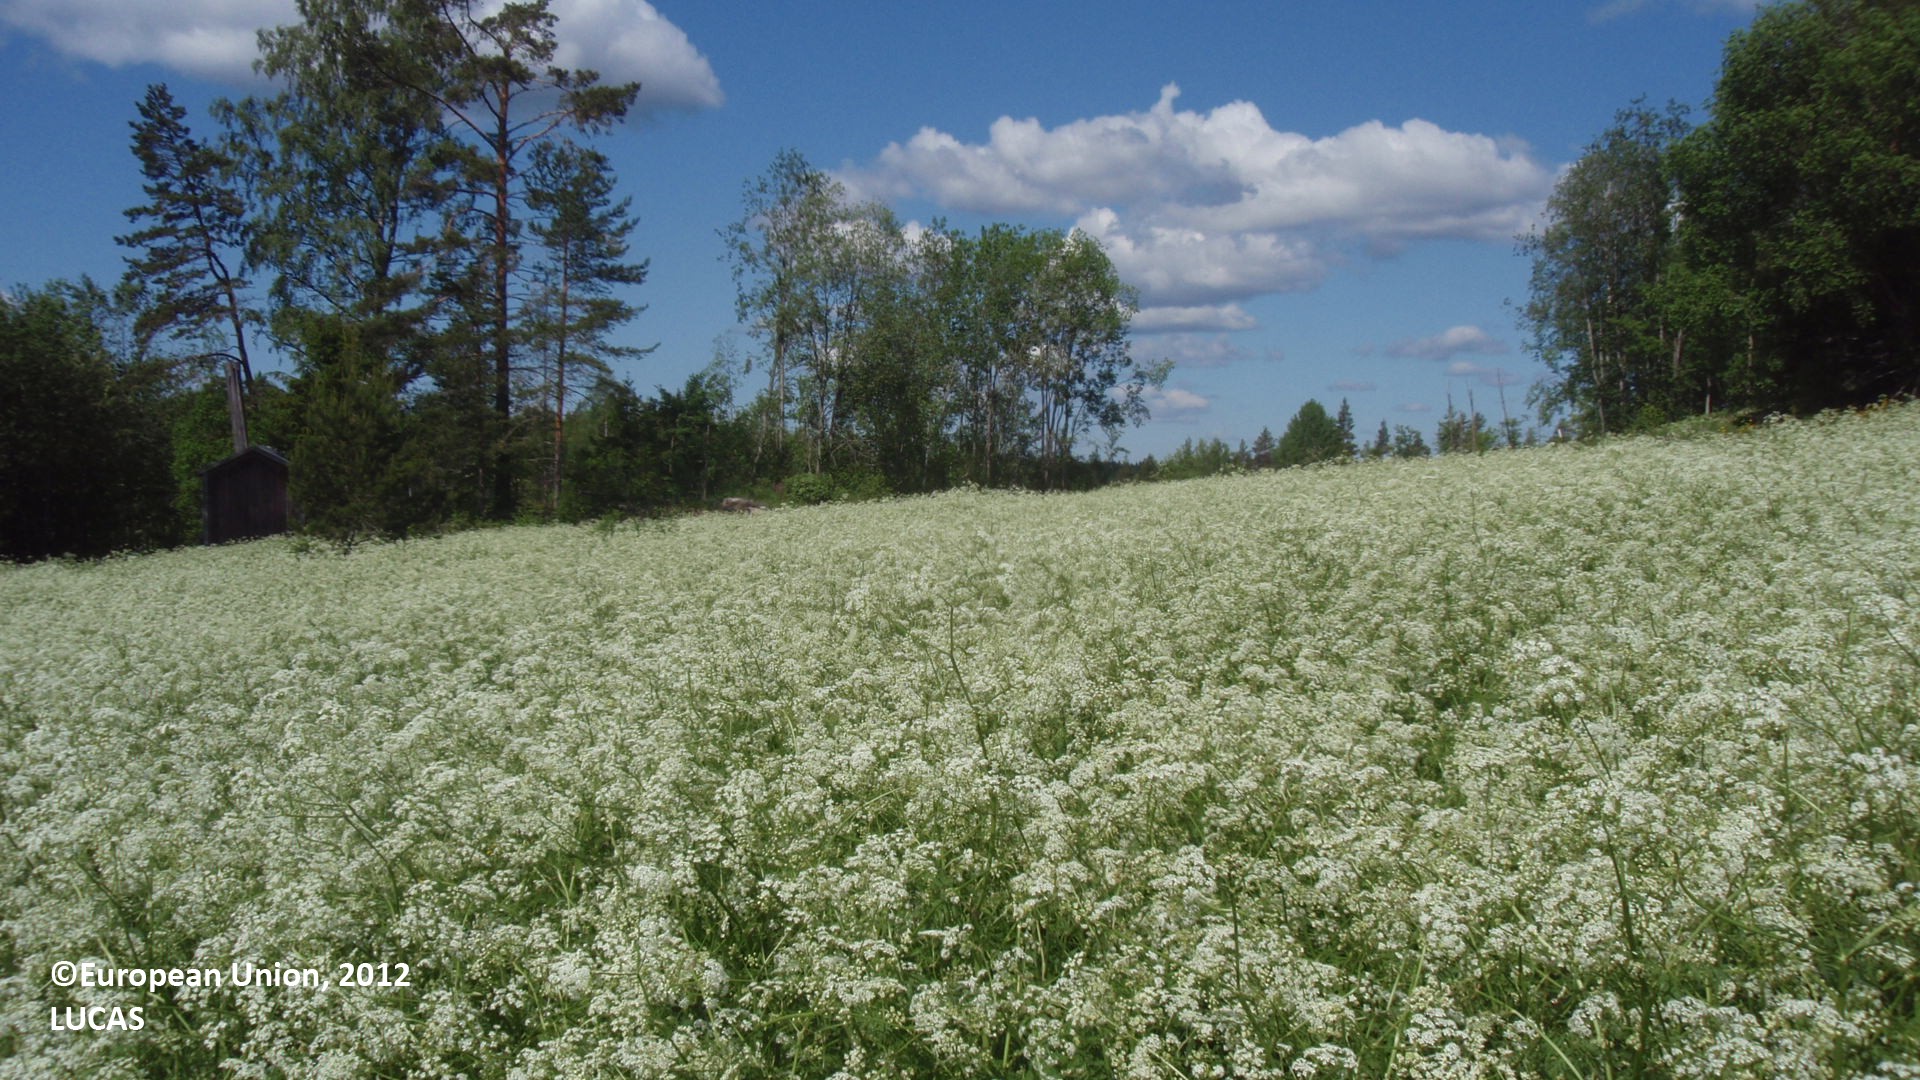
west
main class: Grassland
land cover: Spontaneously vegetated surfaces
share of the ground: > 75 %
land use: Fallow land
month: June
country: FI
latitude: 61.8178
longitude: 28.5258
